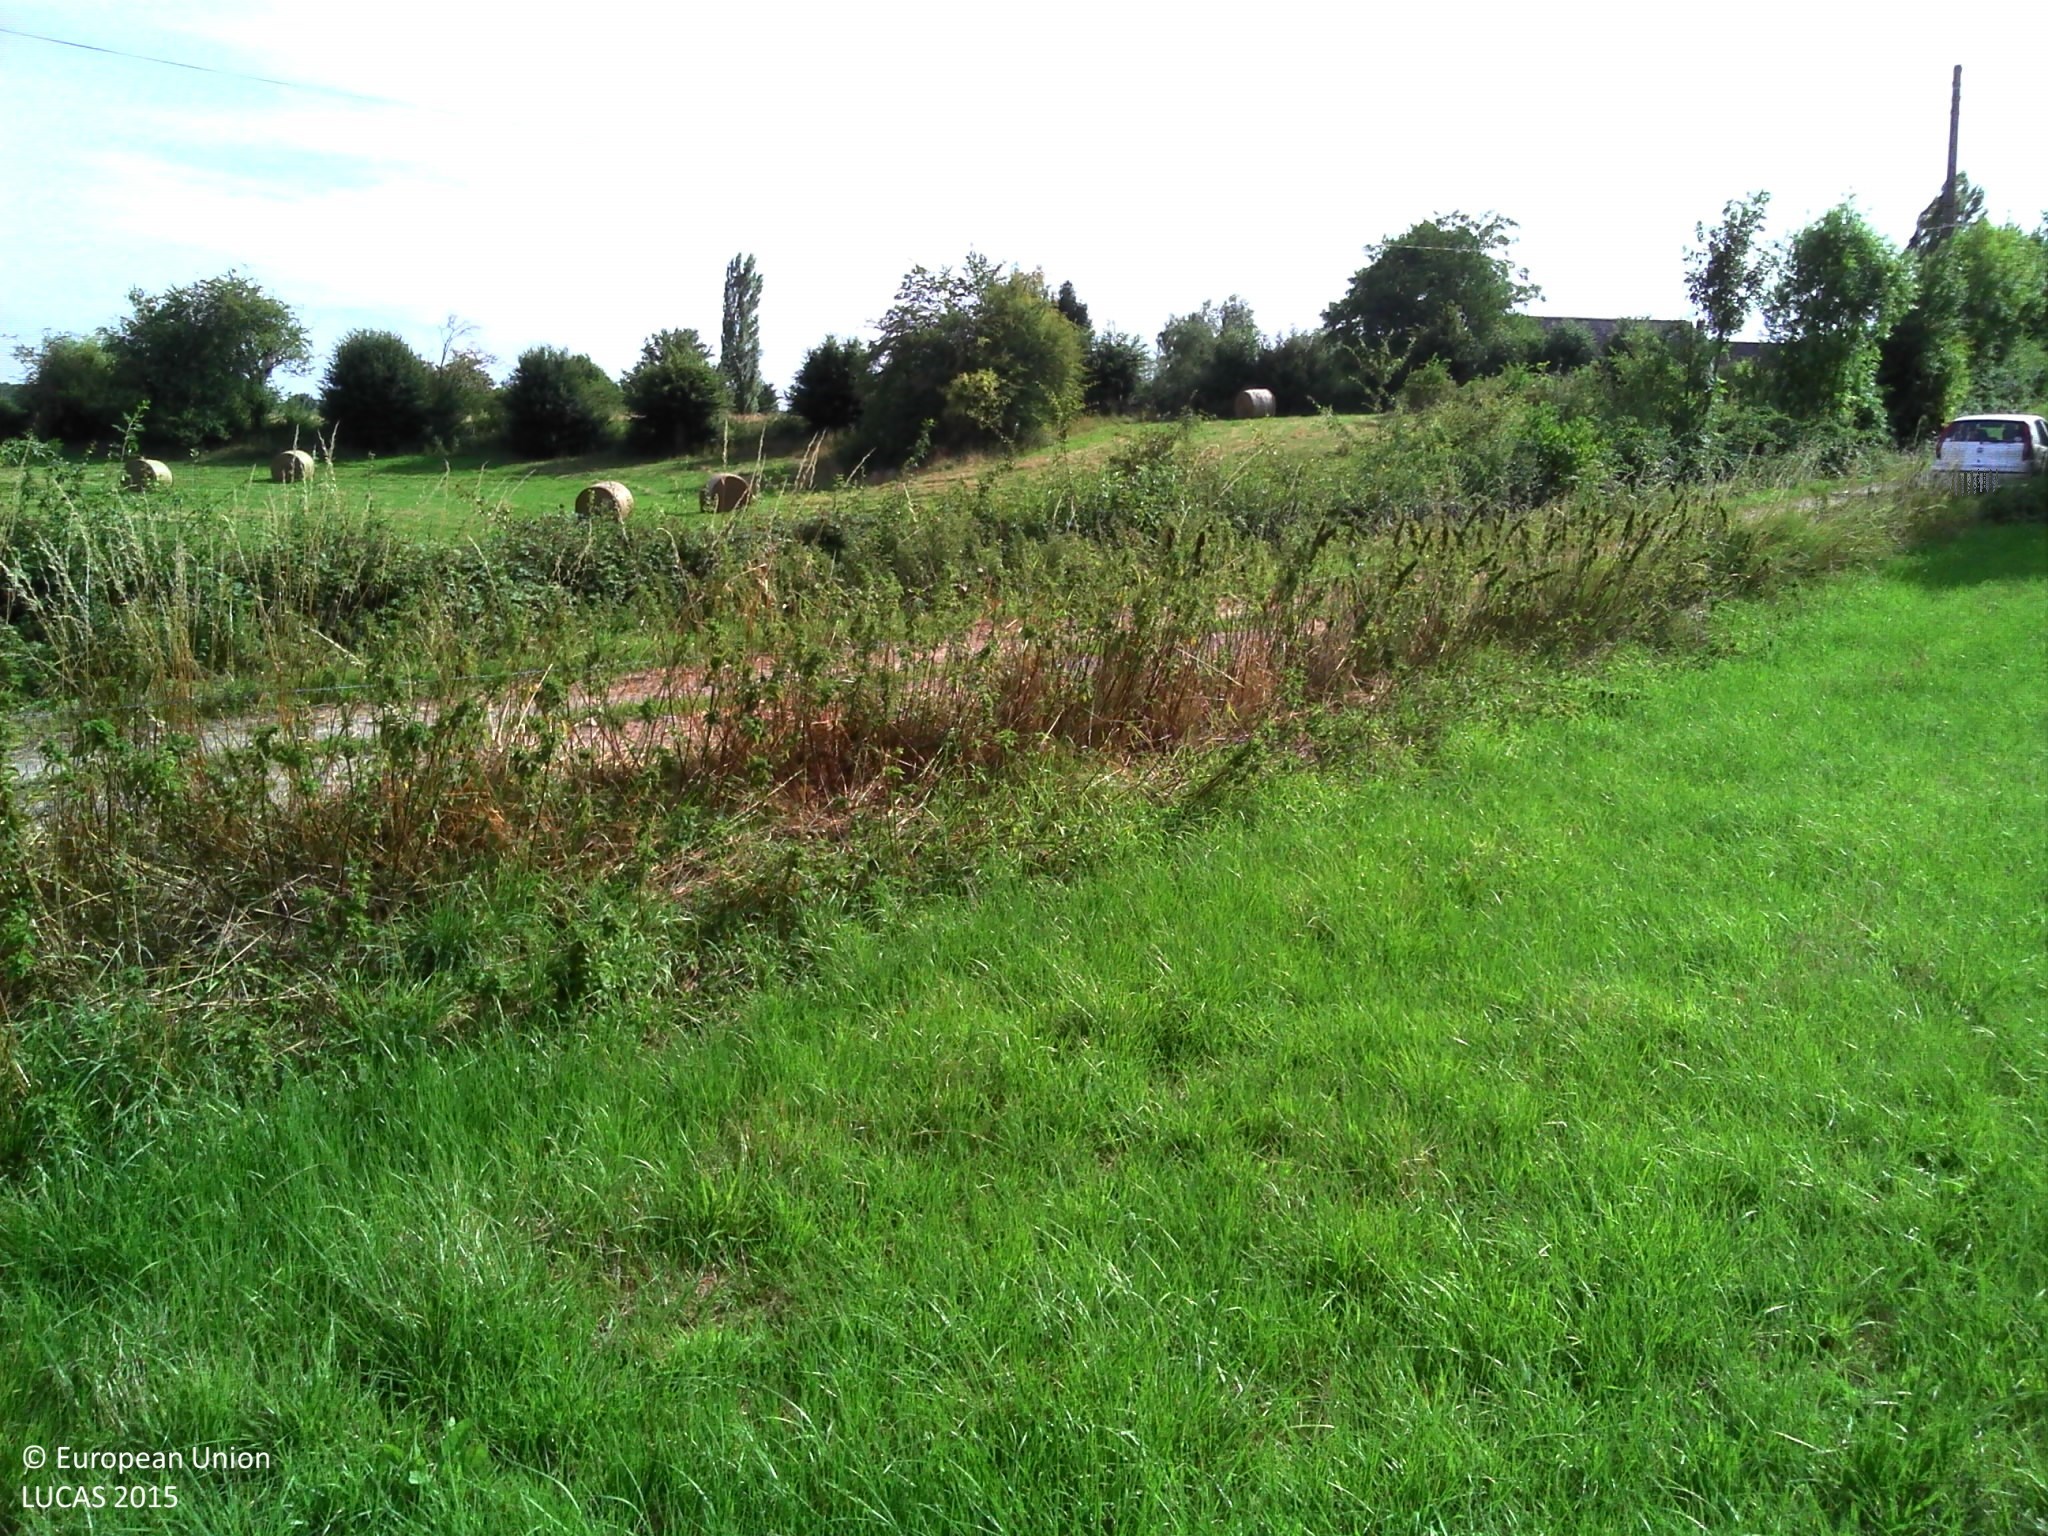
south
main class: Grassland
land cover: Grassland without tree/shrub cover
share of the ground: > 75 %
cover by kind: herbaceous plants 95 %, lichens and mosses 5 %
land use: Agriculture (excluding fallow land and kitchen gardens)
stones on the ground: < 10 %
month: August
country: FR
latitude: 50.0788
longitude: 3.9715
